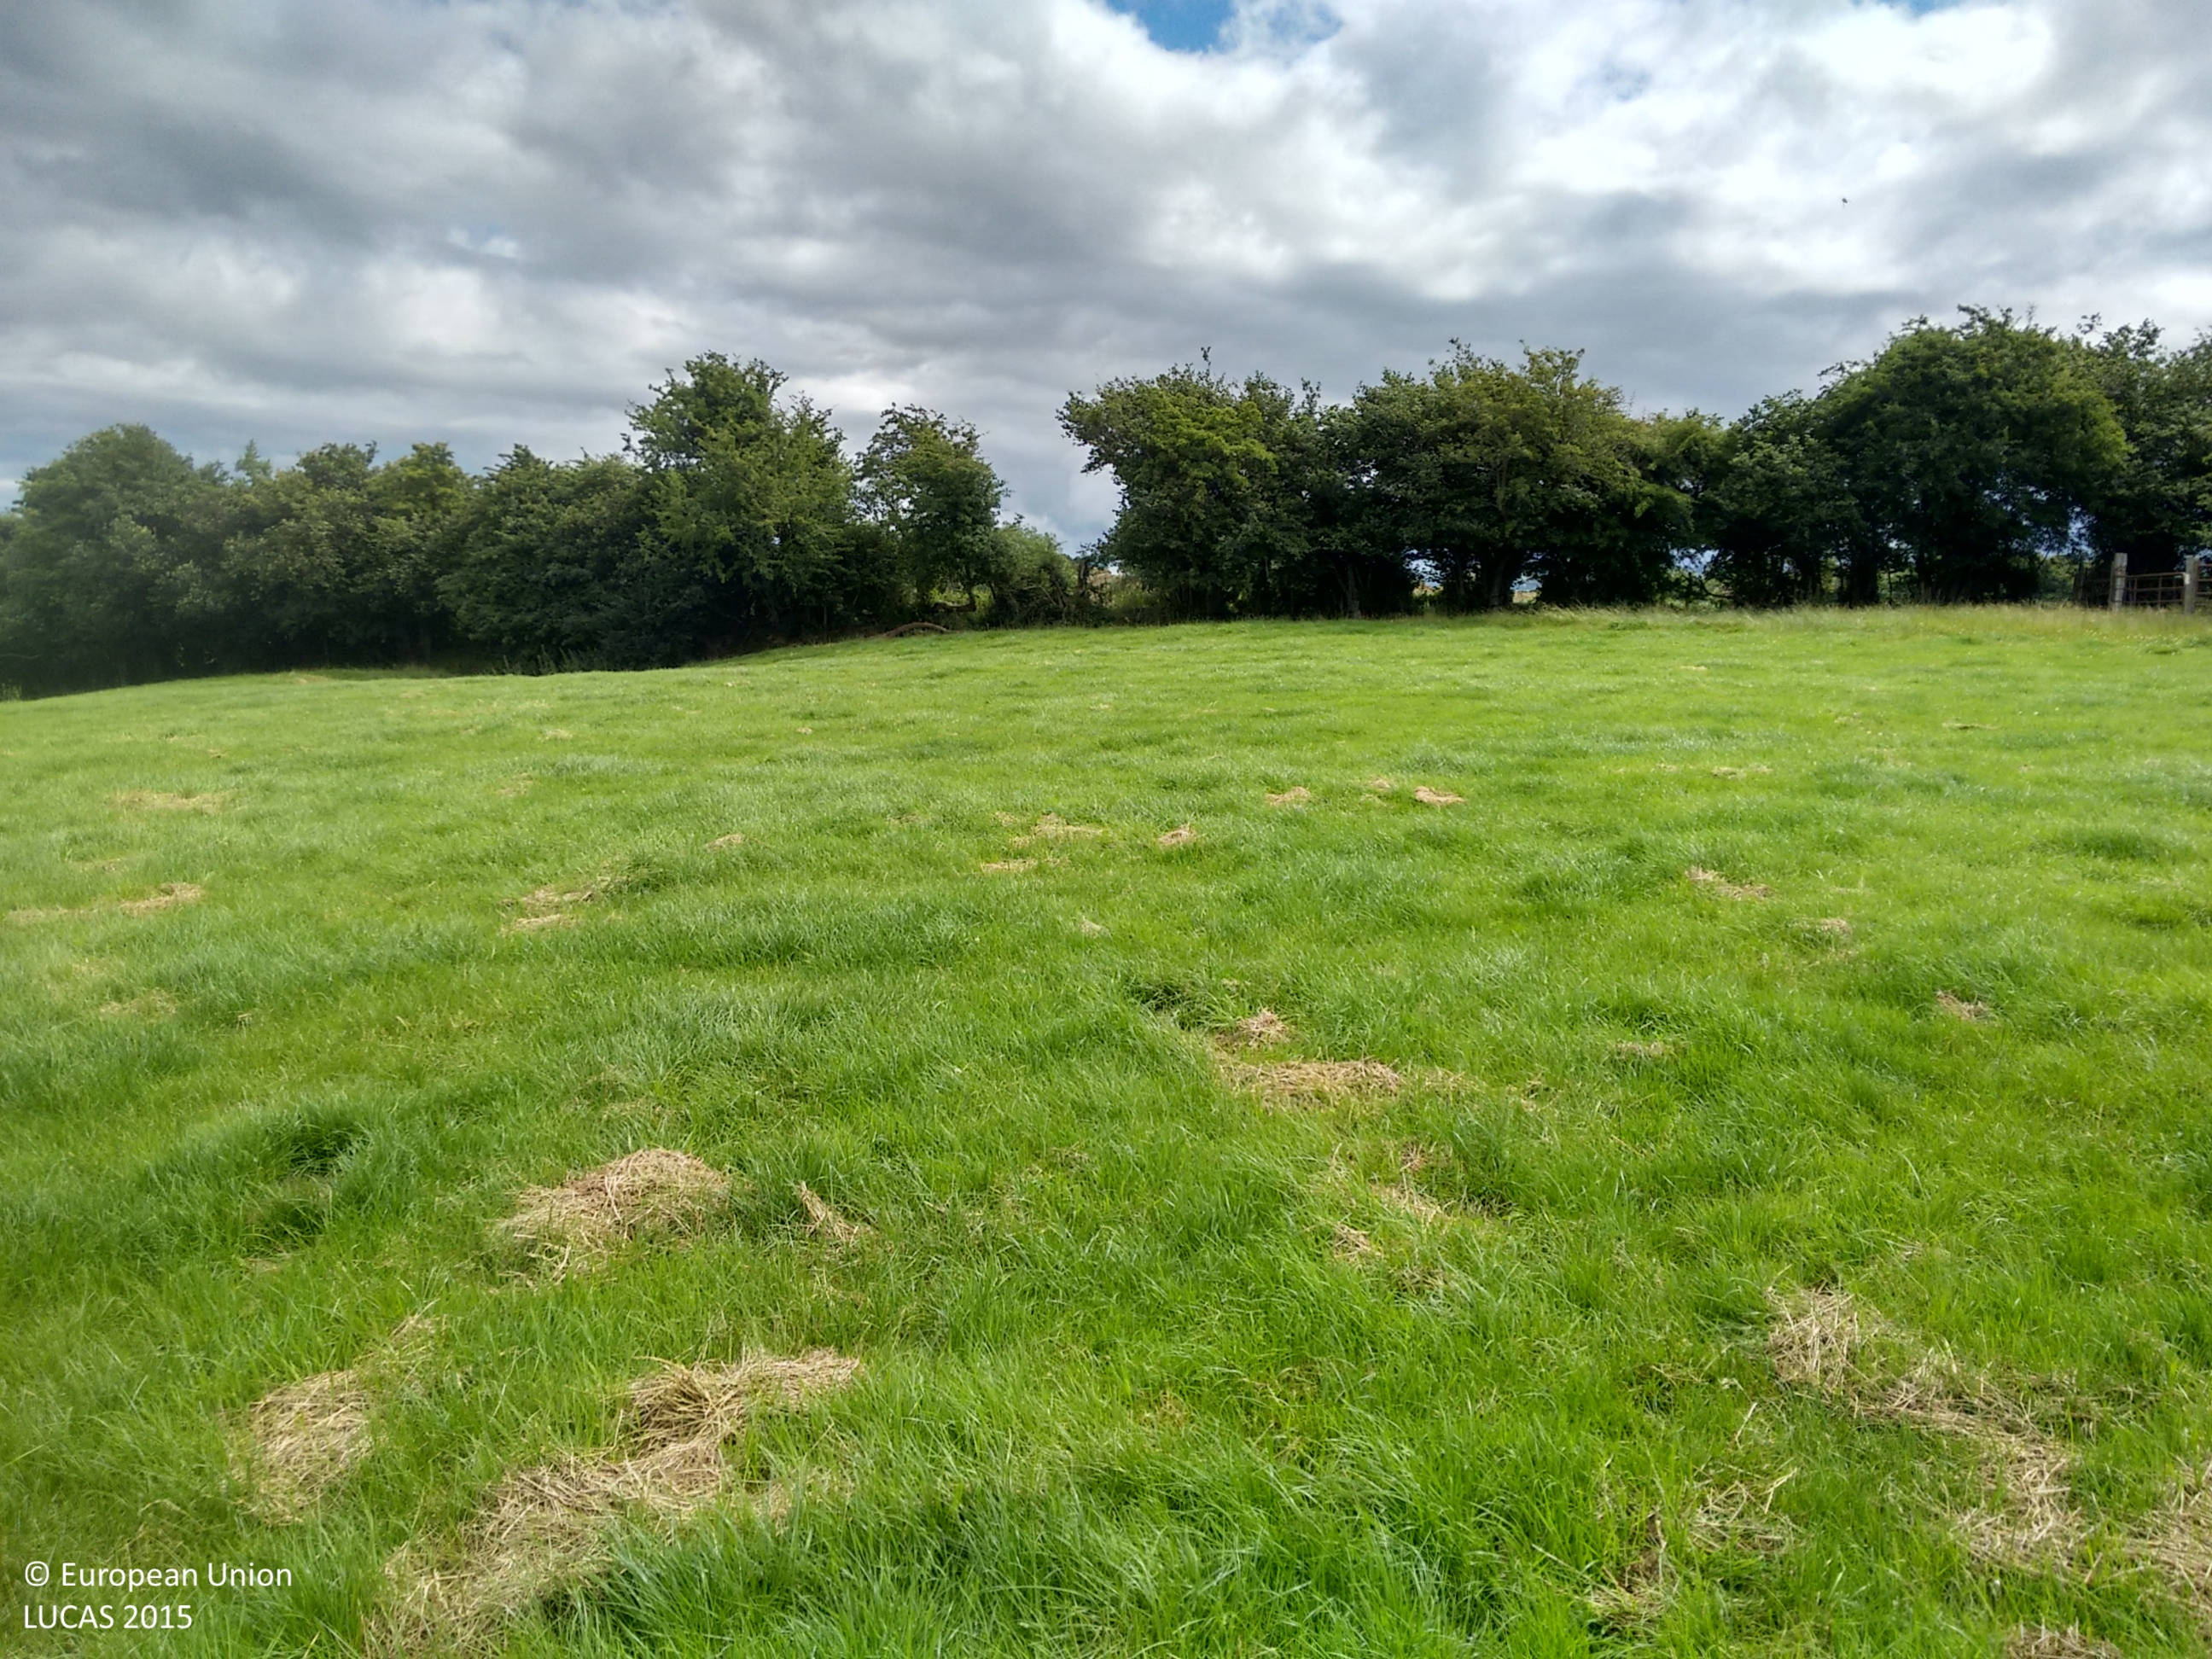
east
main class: Grassland
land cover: Grassland without tree/shrub cover
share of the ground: > 75 %
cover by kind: herbaceous plants 100 %
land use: Agriculture (excluding fallow land and kitchen gardens)
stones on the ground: < 10 %
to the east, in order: Grassland without tree/shrub cover; Managed hedges; Grassland without tree/shrub cover; Managed hedges; Grass margins; Paved roads, cycling and walking lanes; Grass margins; Managed hedges; Grassland without tree/shrub cover; Other bare soil
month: July
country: IE
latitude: 52.9700
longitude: -6.7985
